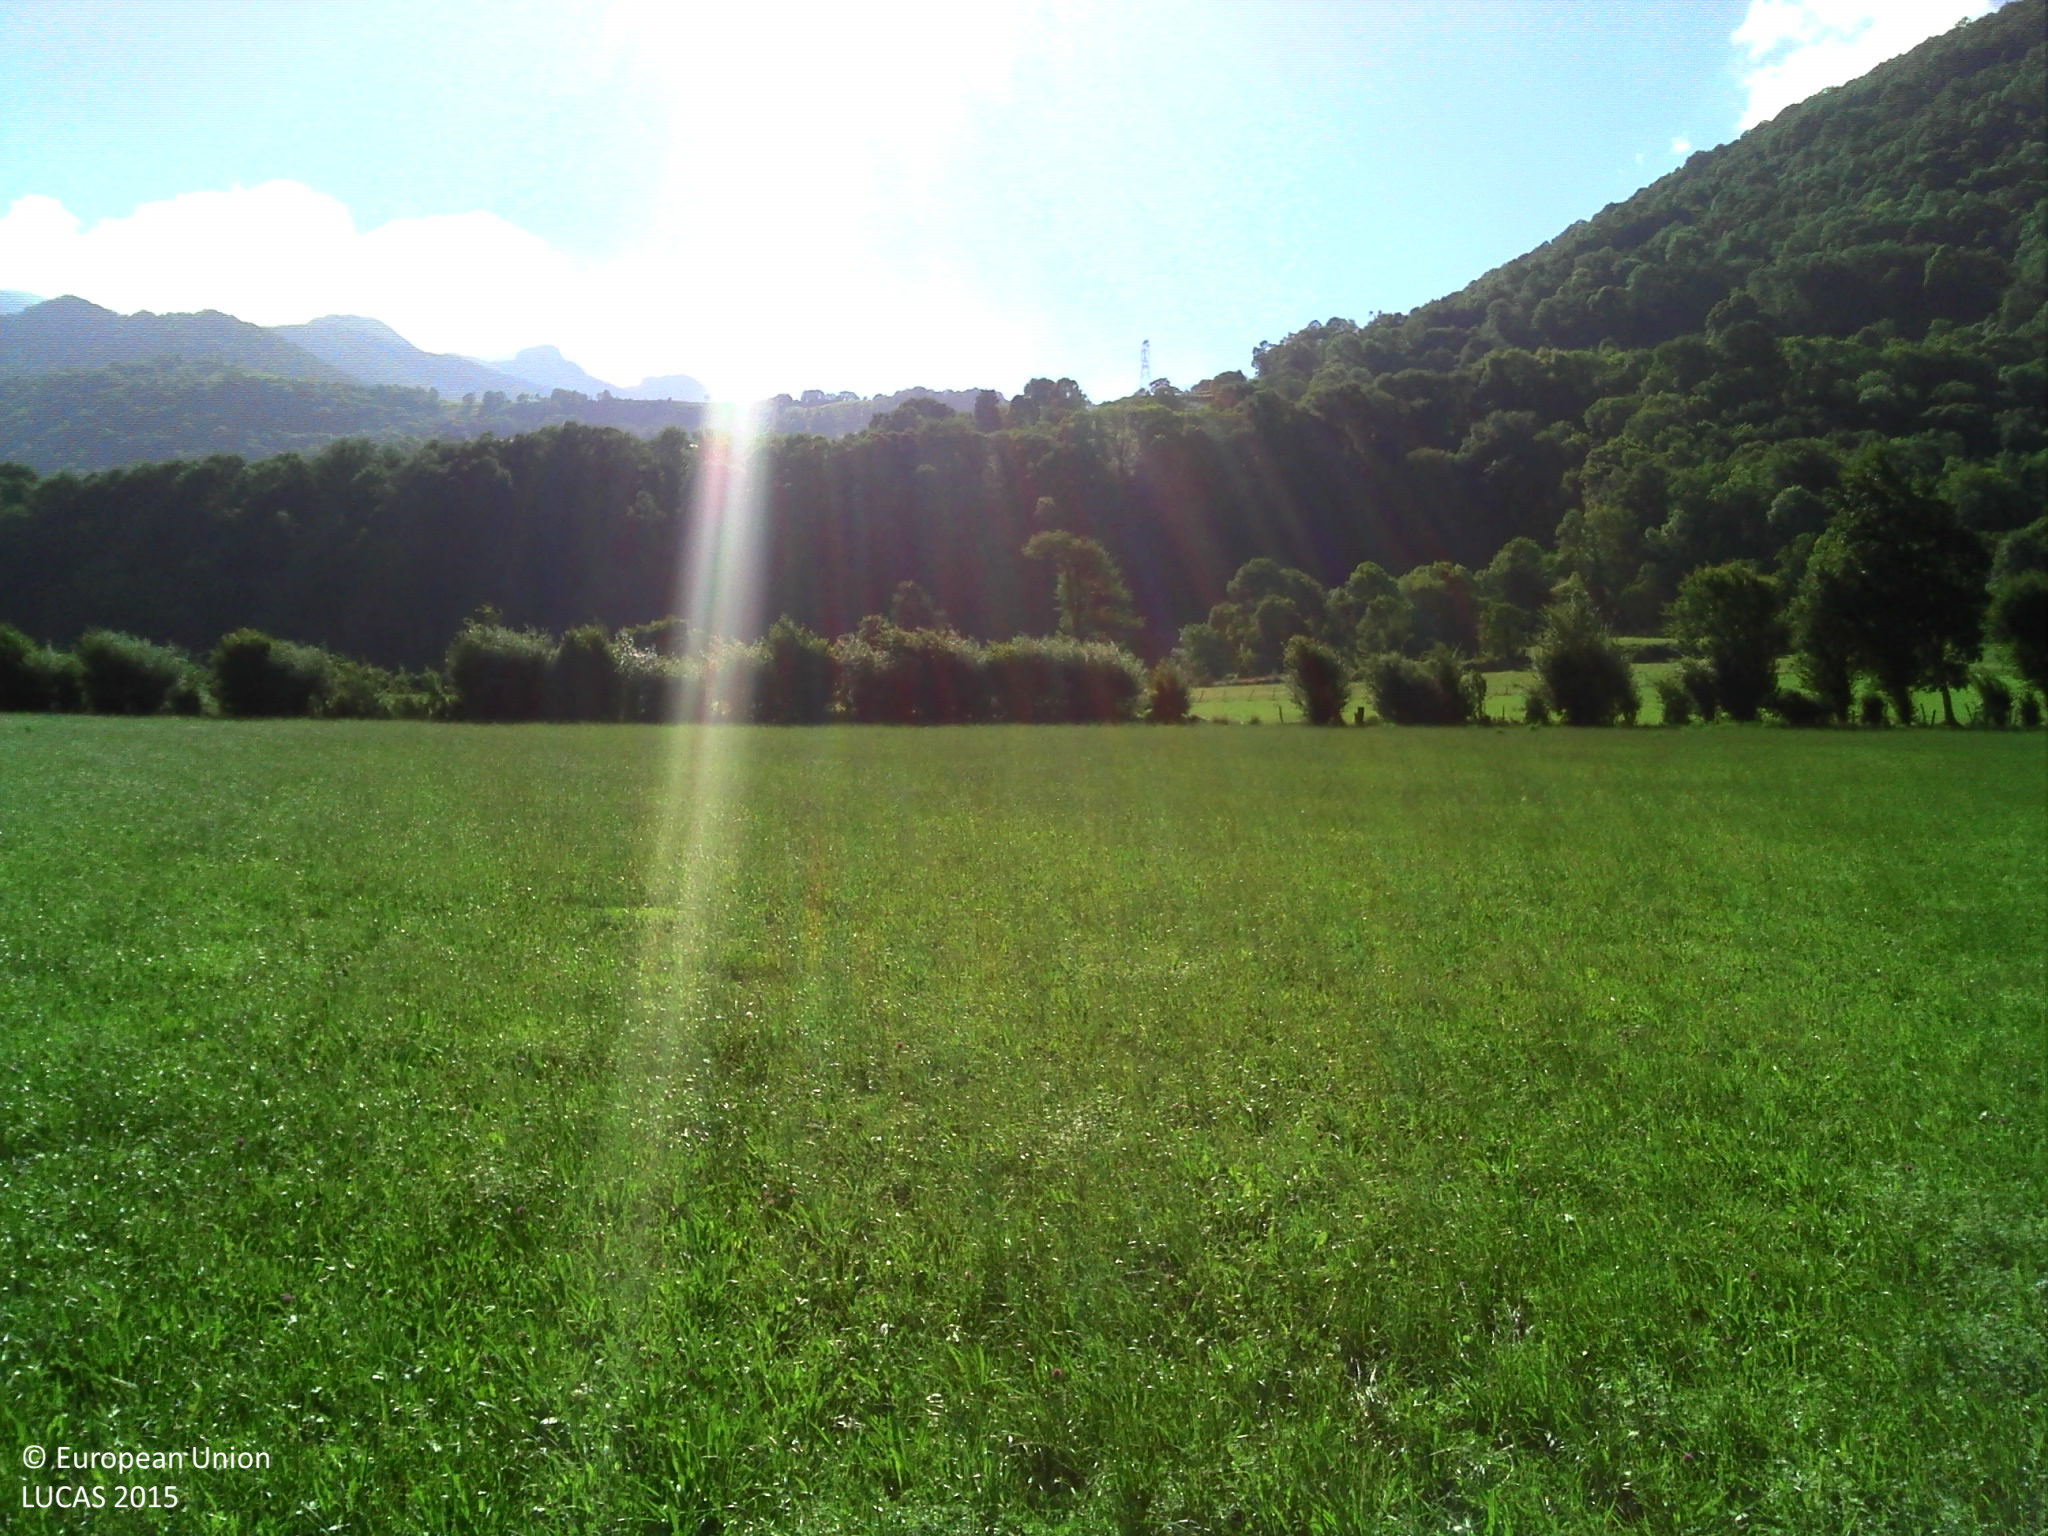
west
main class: Grassland
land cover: Grassland without tree/shrub cover
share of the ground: > 75 %
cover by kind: herbaceous plants 100 %
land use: Agriculture (excluding fallow land and kitchen gardens)
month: July
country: FR
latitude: 43.0600
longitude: -0.4301
